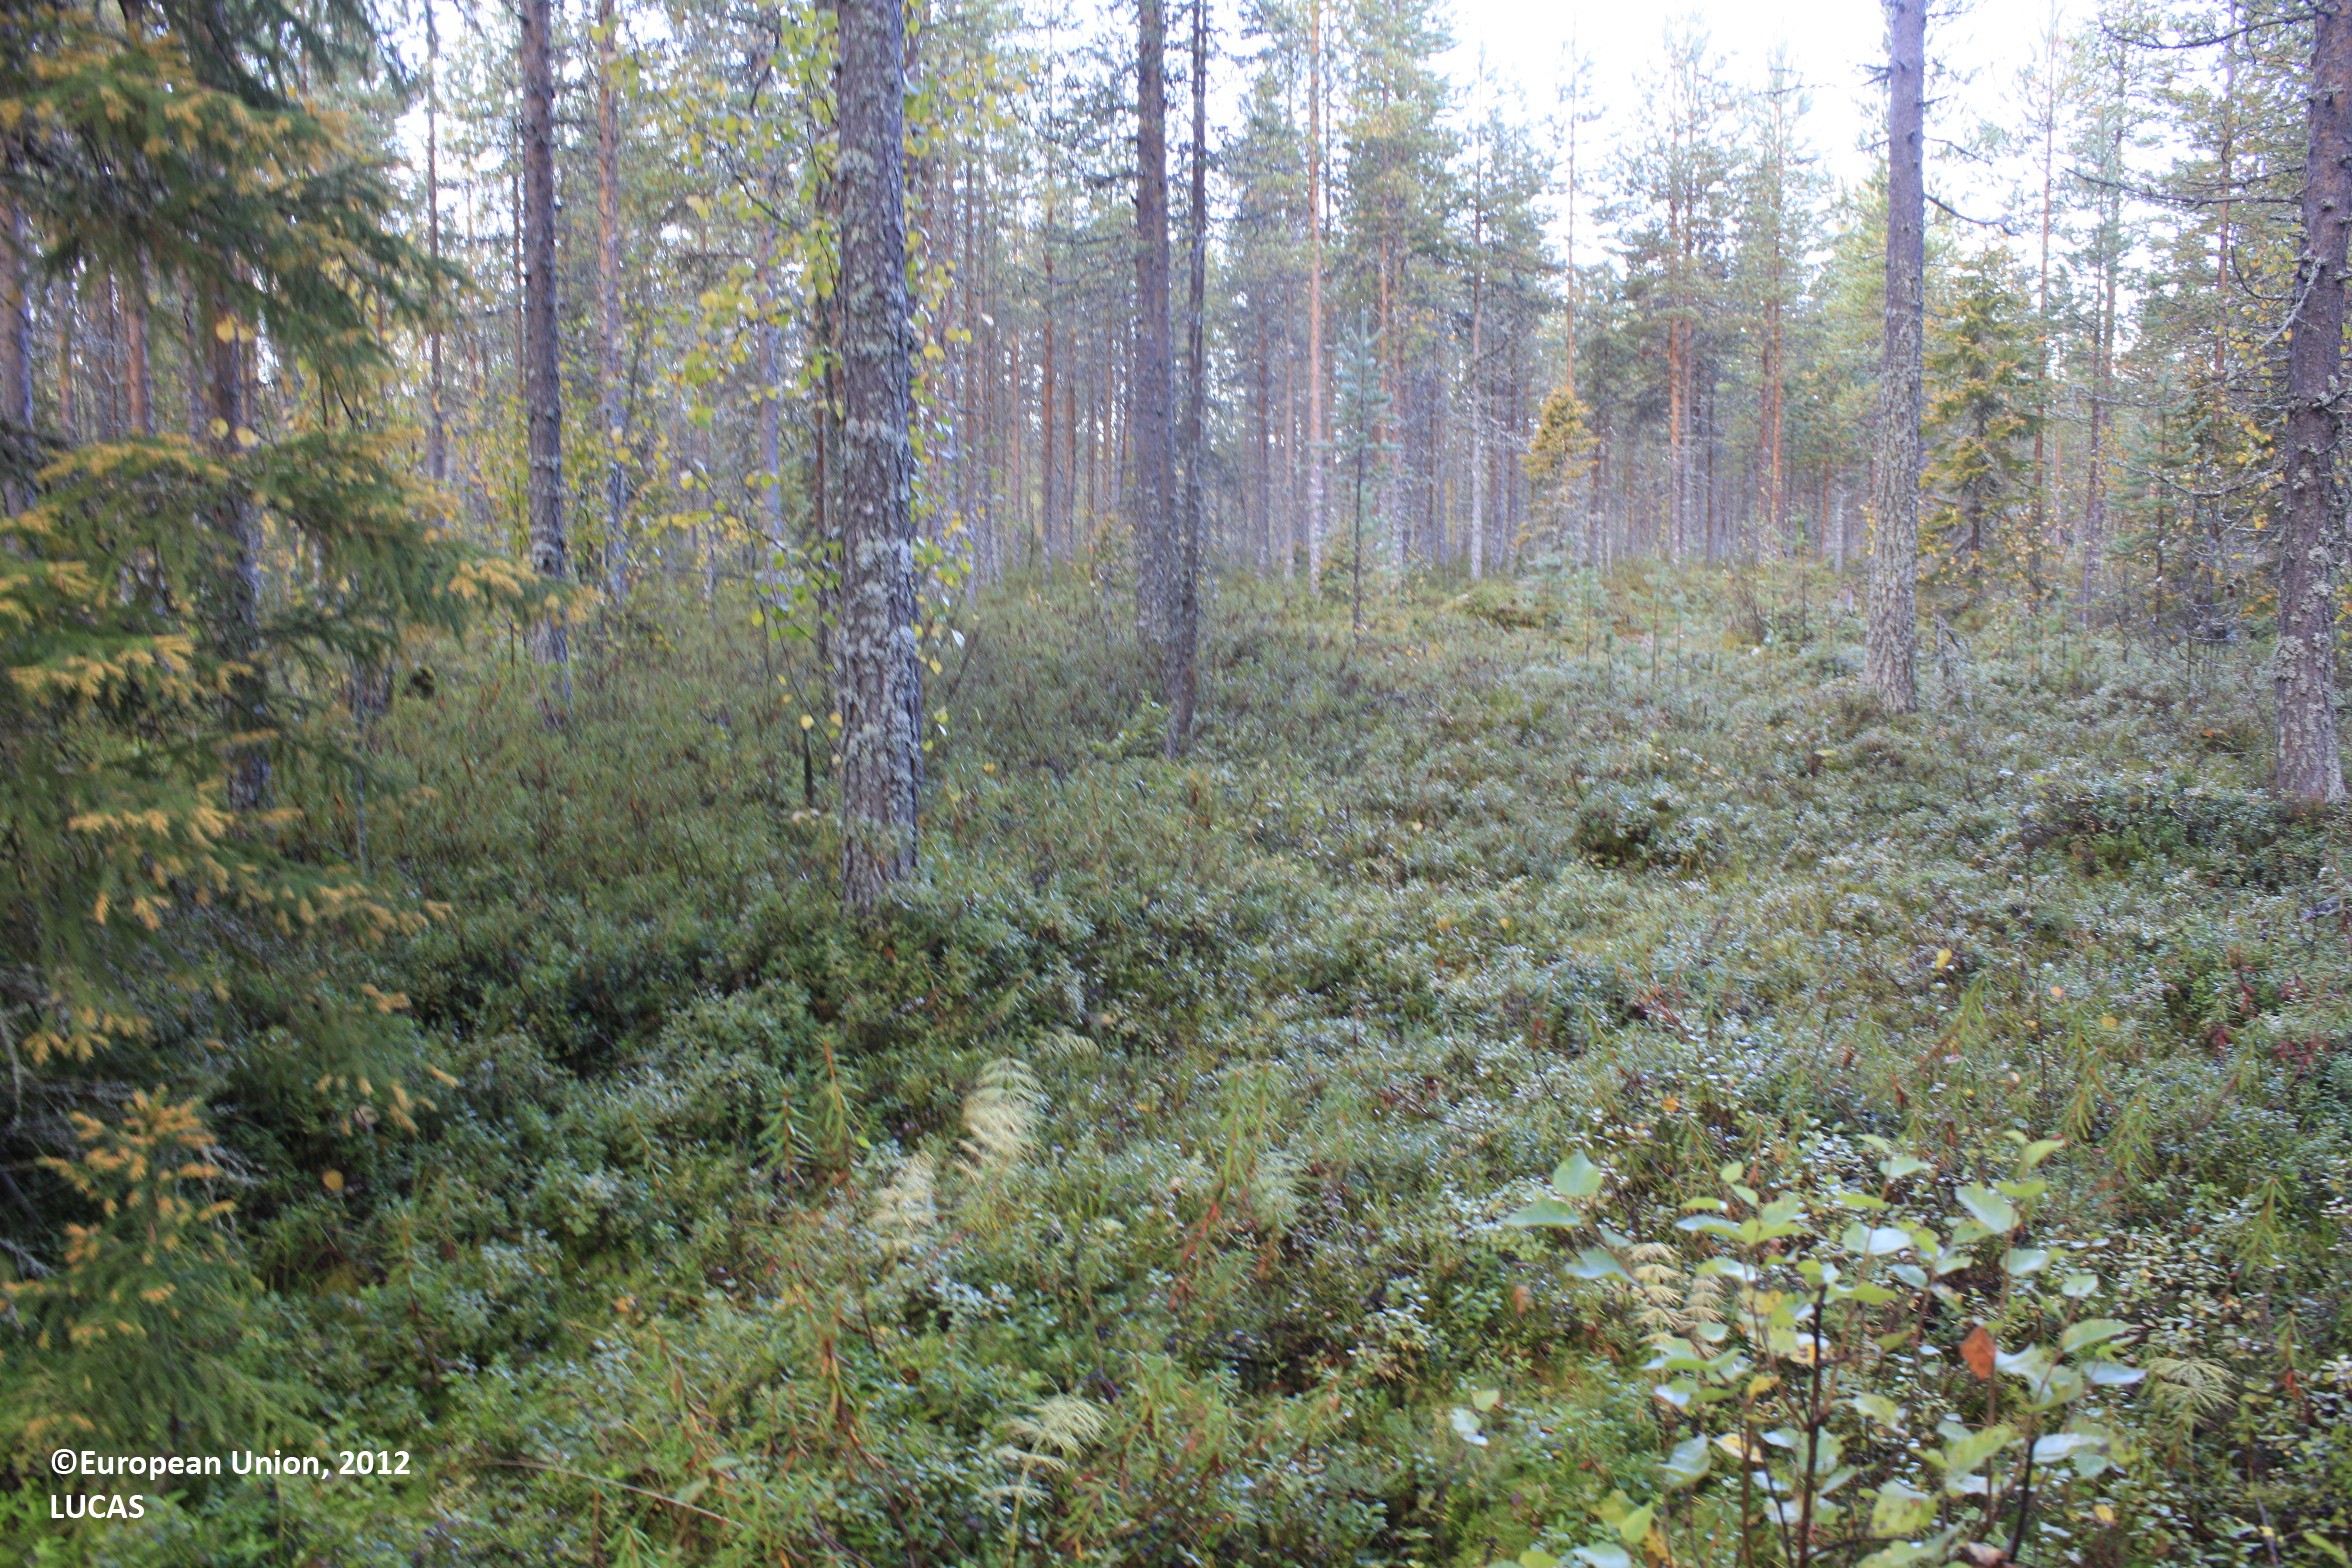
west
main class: Woodland
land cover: Pine dominated mixed woodland
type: boreal forest
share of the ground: 50 - 75 %
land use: Forestry
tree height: > 5 m
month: September
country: FI
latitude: 65.4797
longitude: 26.6246
